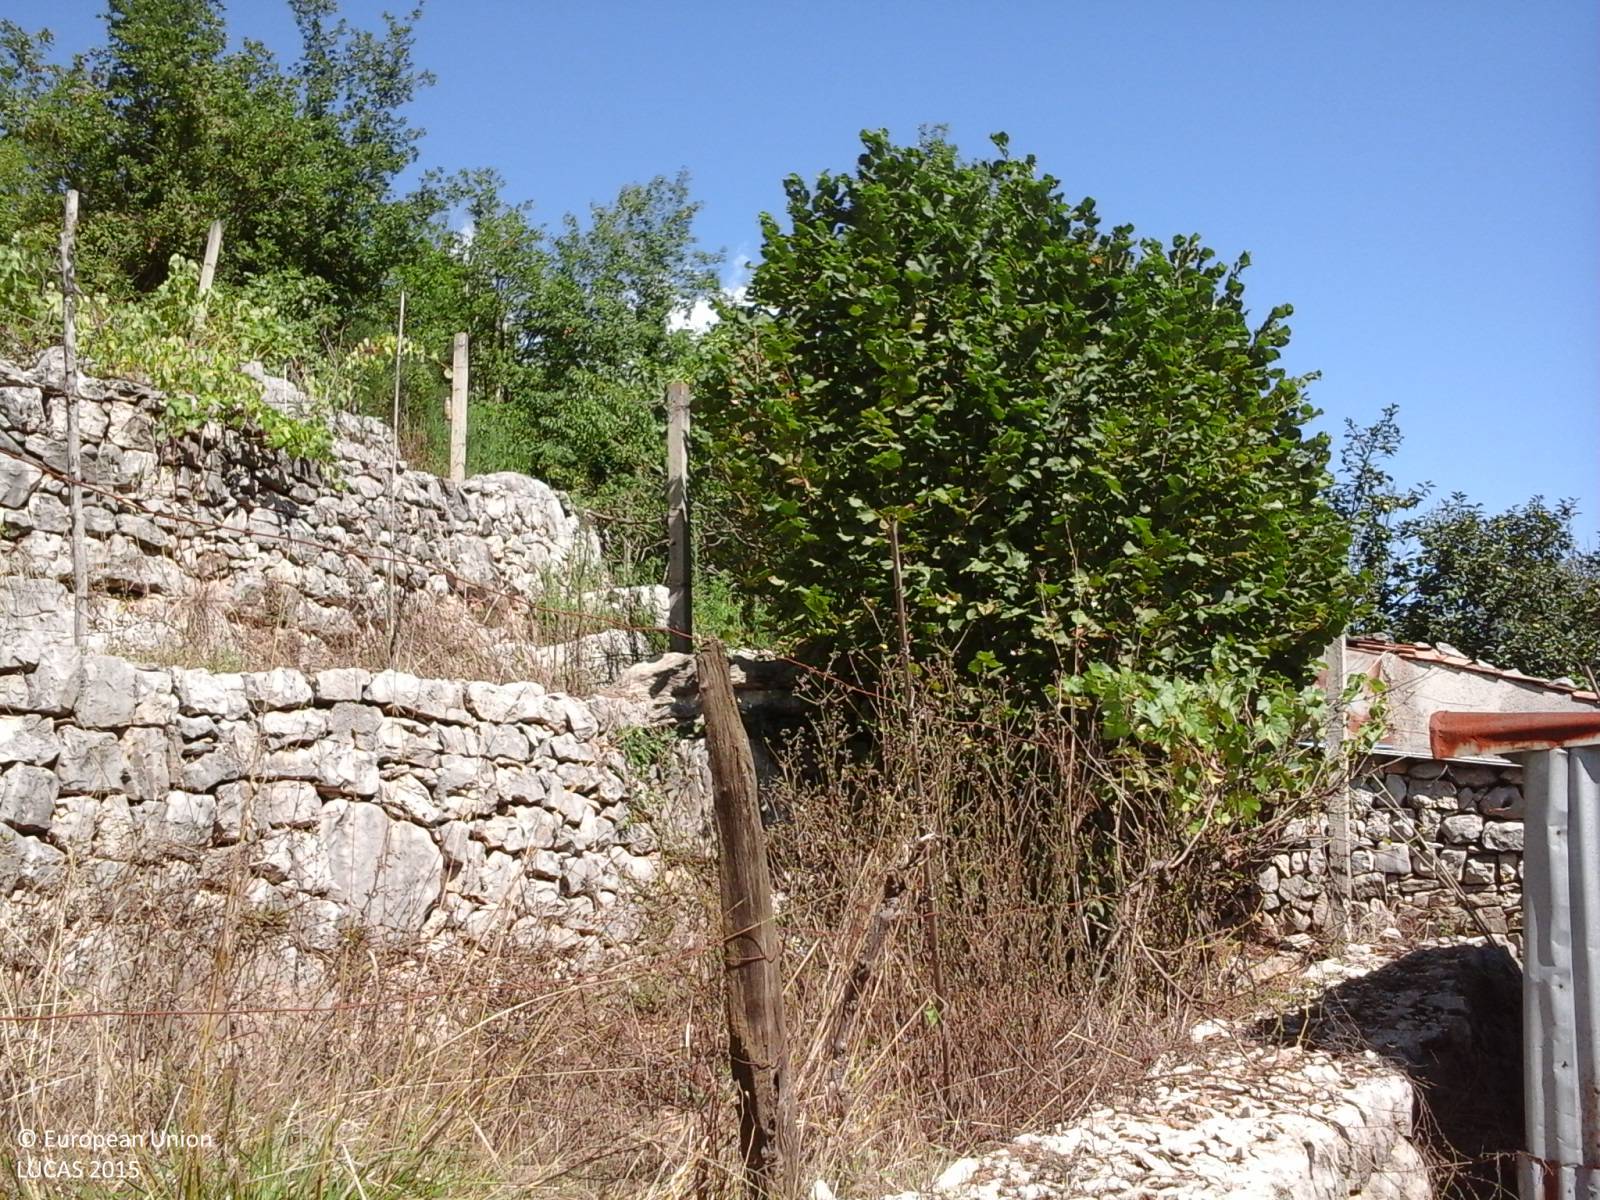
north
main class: Cropland
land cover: Vineyards
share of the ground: 25 - 50 %
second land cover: Spontaneously vegetated surfaces
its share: > 75 %
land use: Agriculture (excluding fallow land and kitchen gardens)
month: August
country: IT
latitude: 41.4577
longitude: 13.3987
